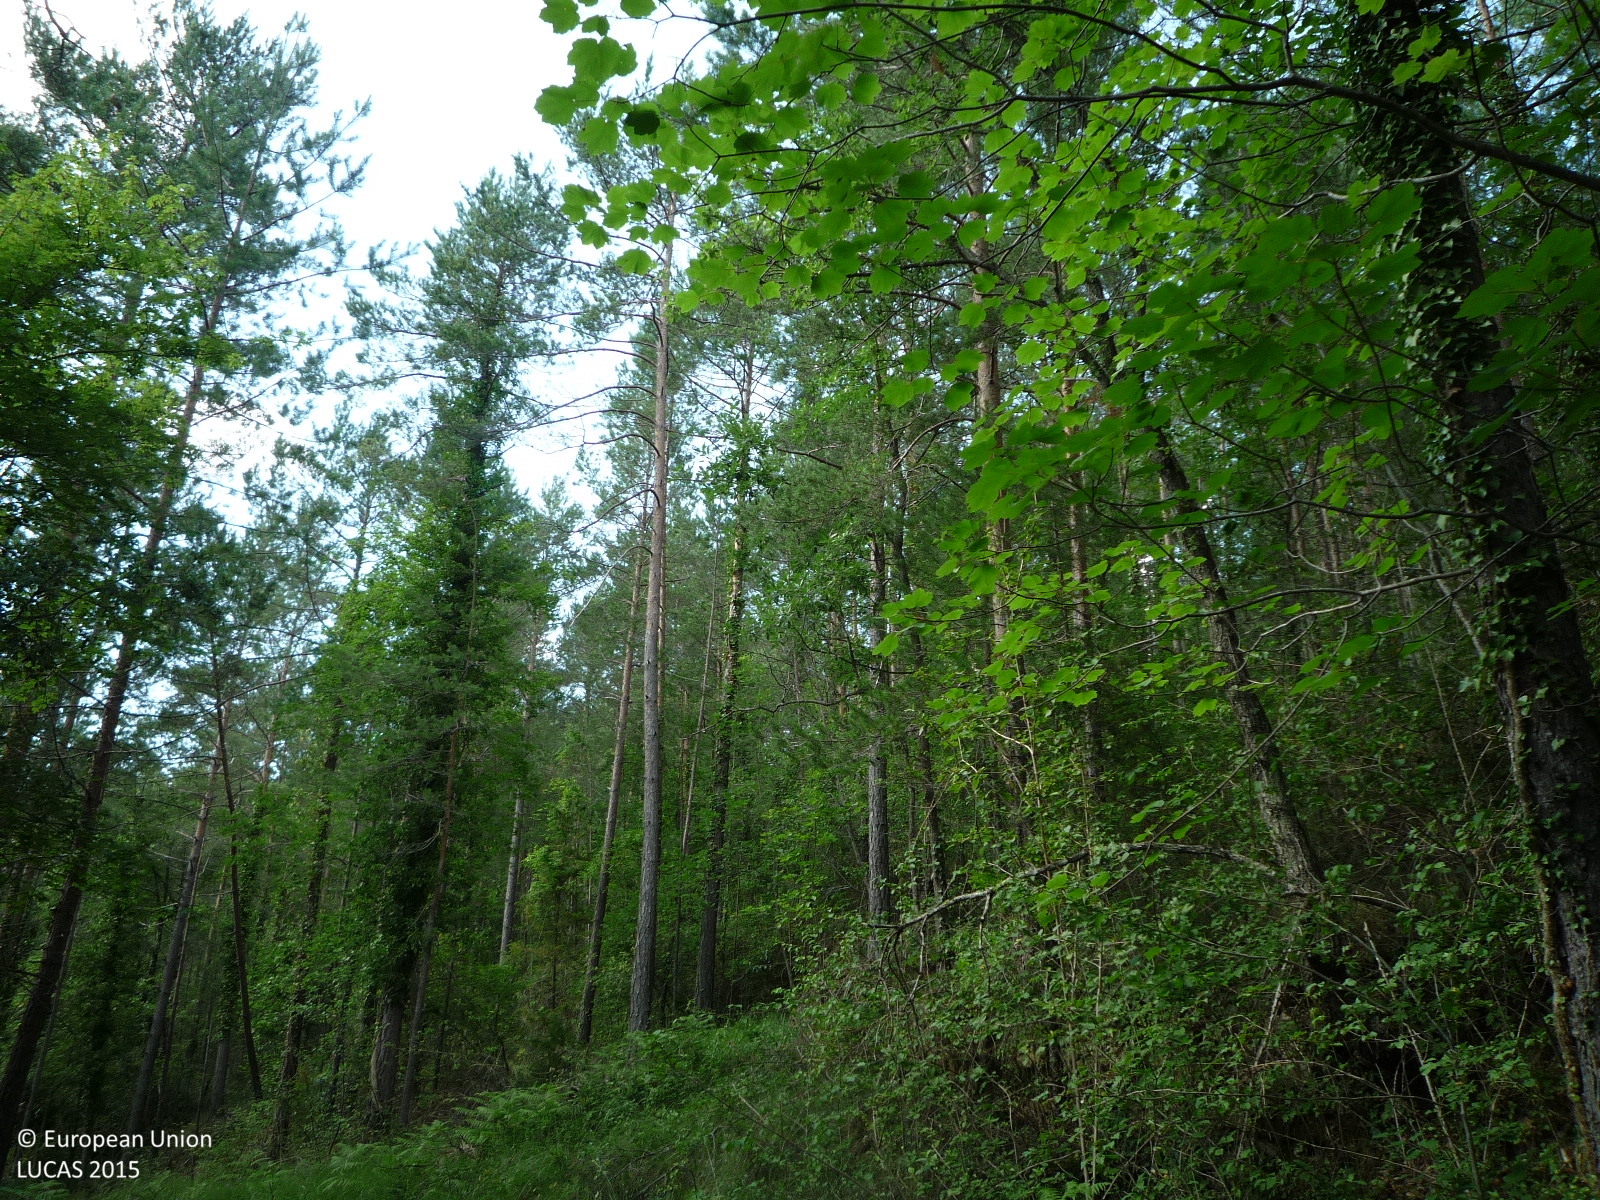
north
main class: Woodland
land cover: Pine dominated mixed woodland
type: coniferous forest of the mediterranean region
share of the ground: > 75 %
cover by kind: coniferous forest trees 60 %, broadleaved forest trees 30 %, herbaceous plants 10 %
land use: Forestry
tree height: > 5 m
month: June
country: ES
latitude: 42.1350
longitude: 1.9676
